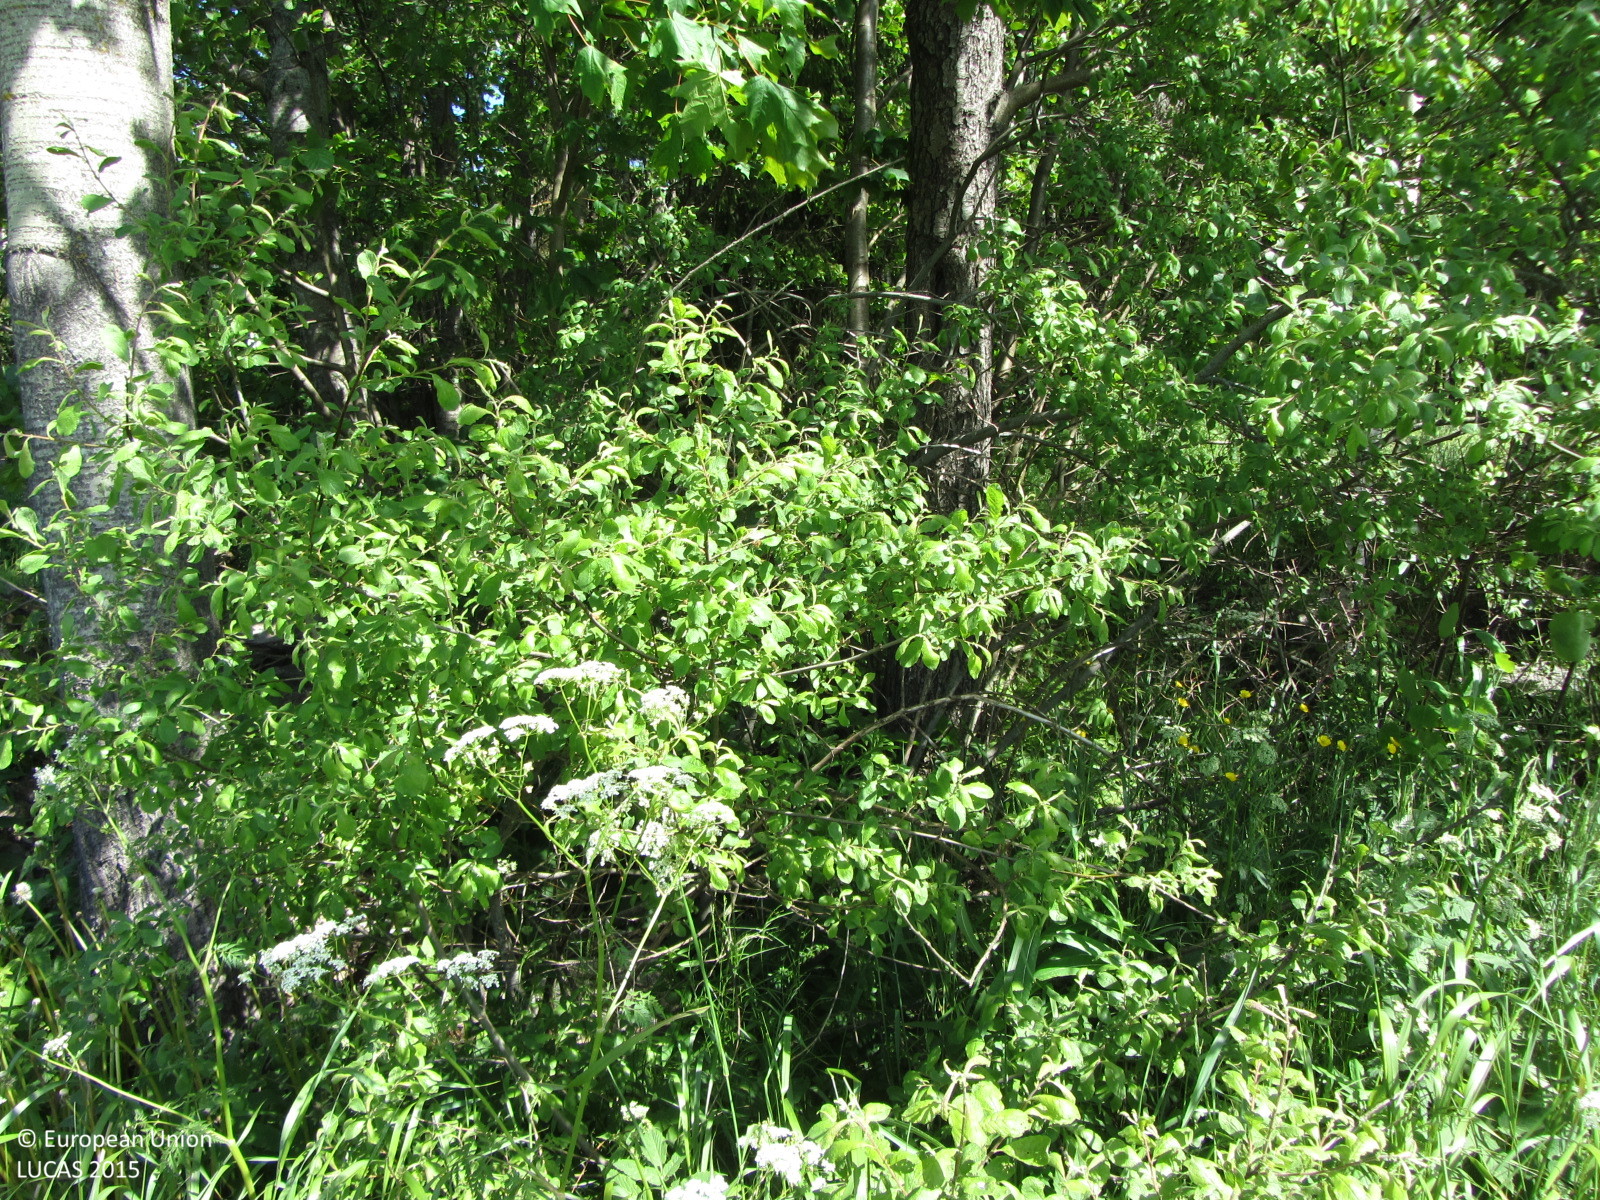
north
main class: Grassland
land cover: Grassland with sparse tree/shrub cover
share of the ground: > 75 %
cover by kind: herbaceous plants 90 %, broadleaved forest trees 5 %, shrubs 5 %
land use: Agriculture (excluding fallow land and kitchen gardens)
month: June
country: FI
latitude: 60.1986
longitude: 24.3005
